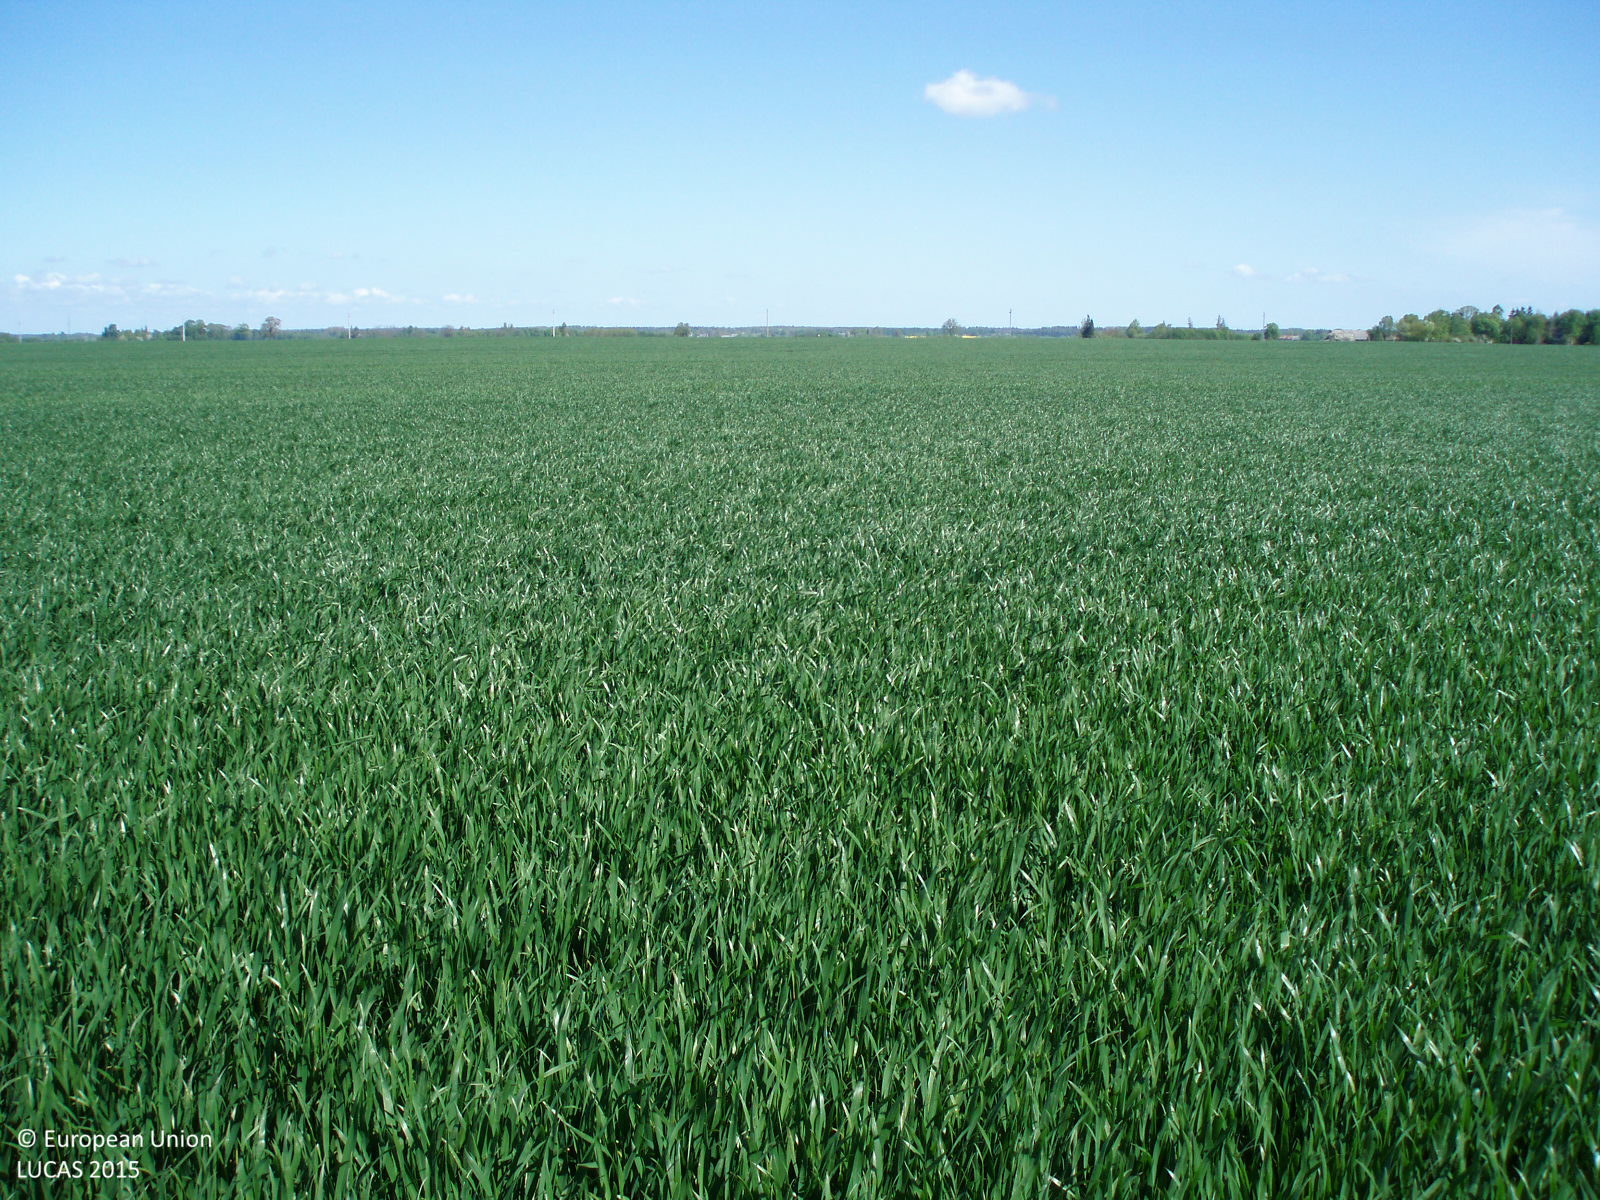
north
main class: Cropland
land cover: Barley
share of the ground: > 75 %
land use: Agriculture (excluding fallow land and kitchen gardens)
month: May
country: LT
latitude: 56.3441
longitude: 22.6311
